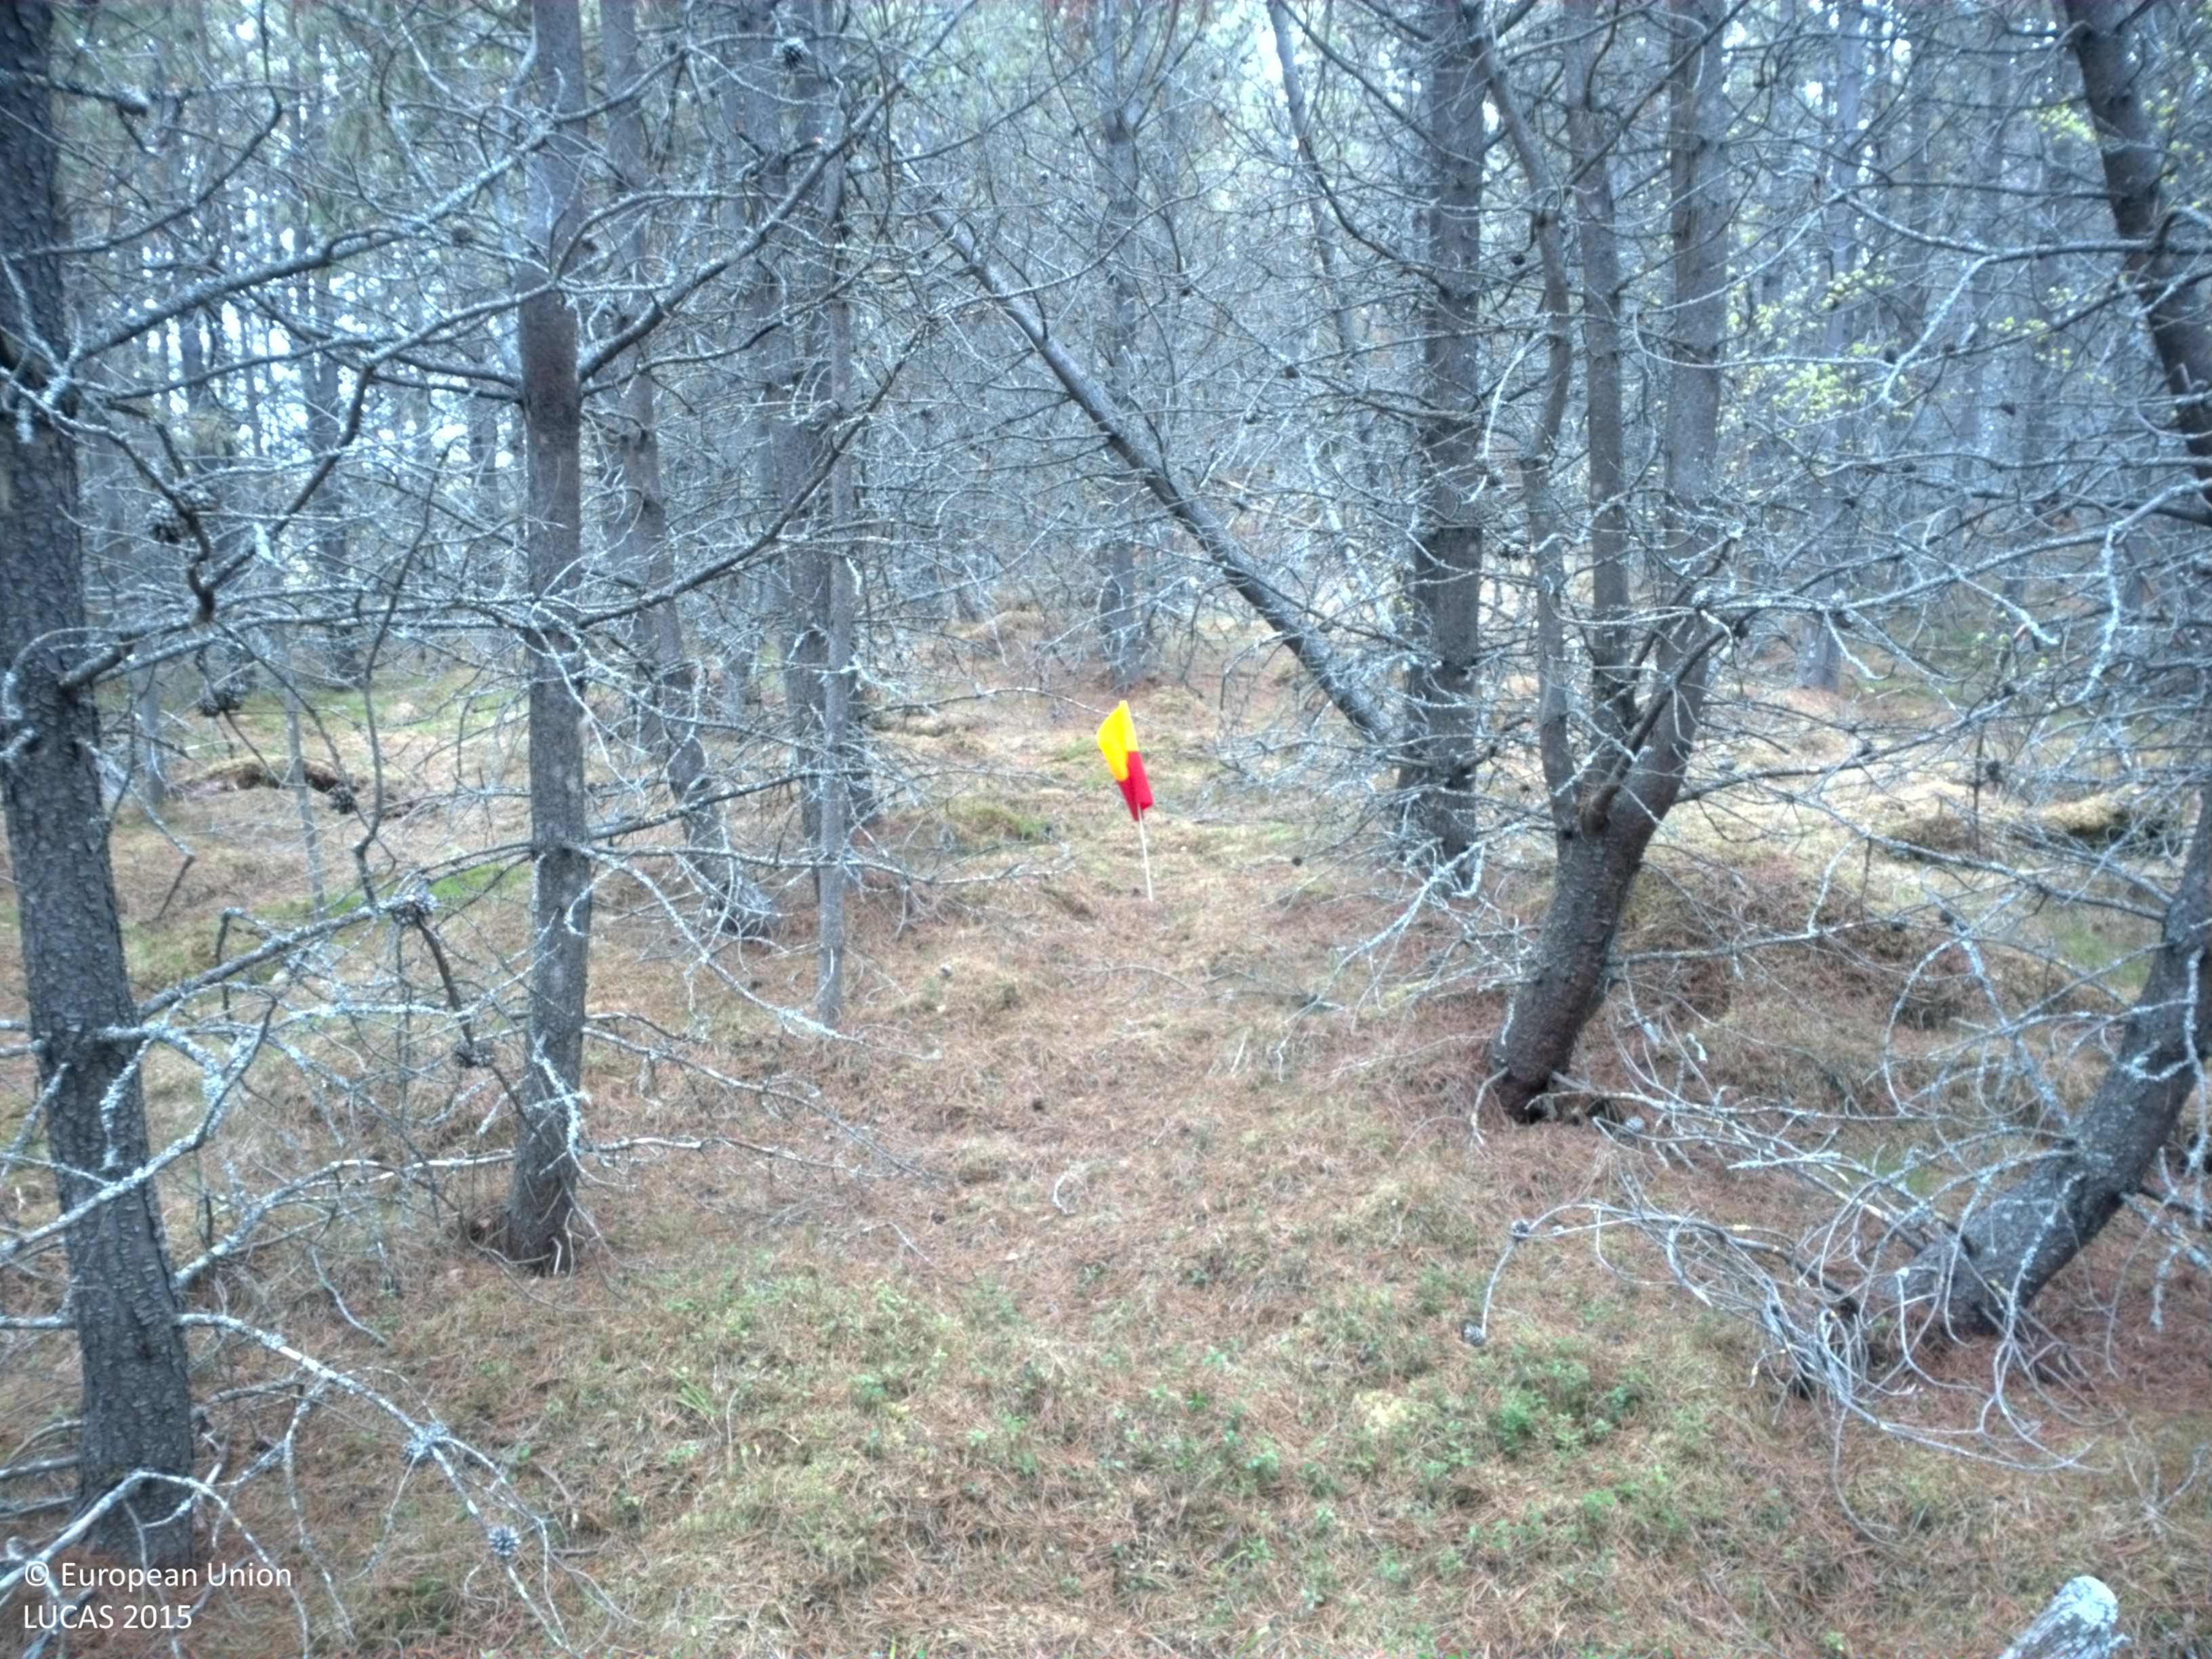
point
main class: Woodland
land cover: Pine dominated coniferous woodland
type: exotic forest
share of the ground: 50 - 75 %
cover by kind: coniferous forest trees 50 %, lichens and mosses 30 %, herbaceous plants 10 %, broadleaved forest trees 5 %, shrubs 5 %
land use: Forestry
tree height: > 5 m
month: June
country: SE
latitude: 64.3108
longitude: 17.5151
